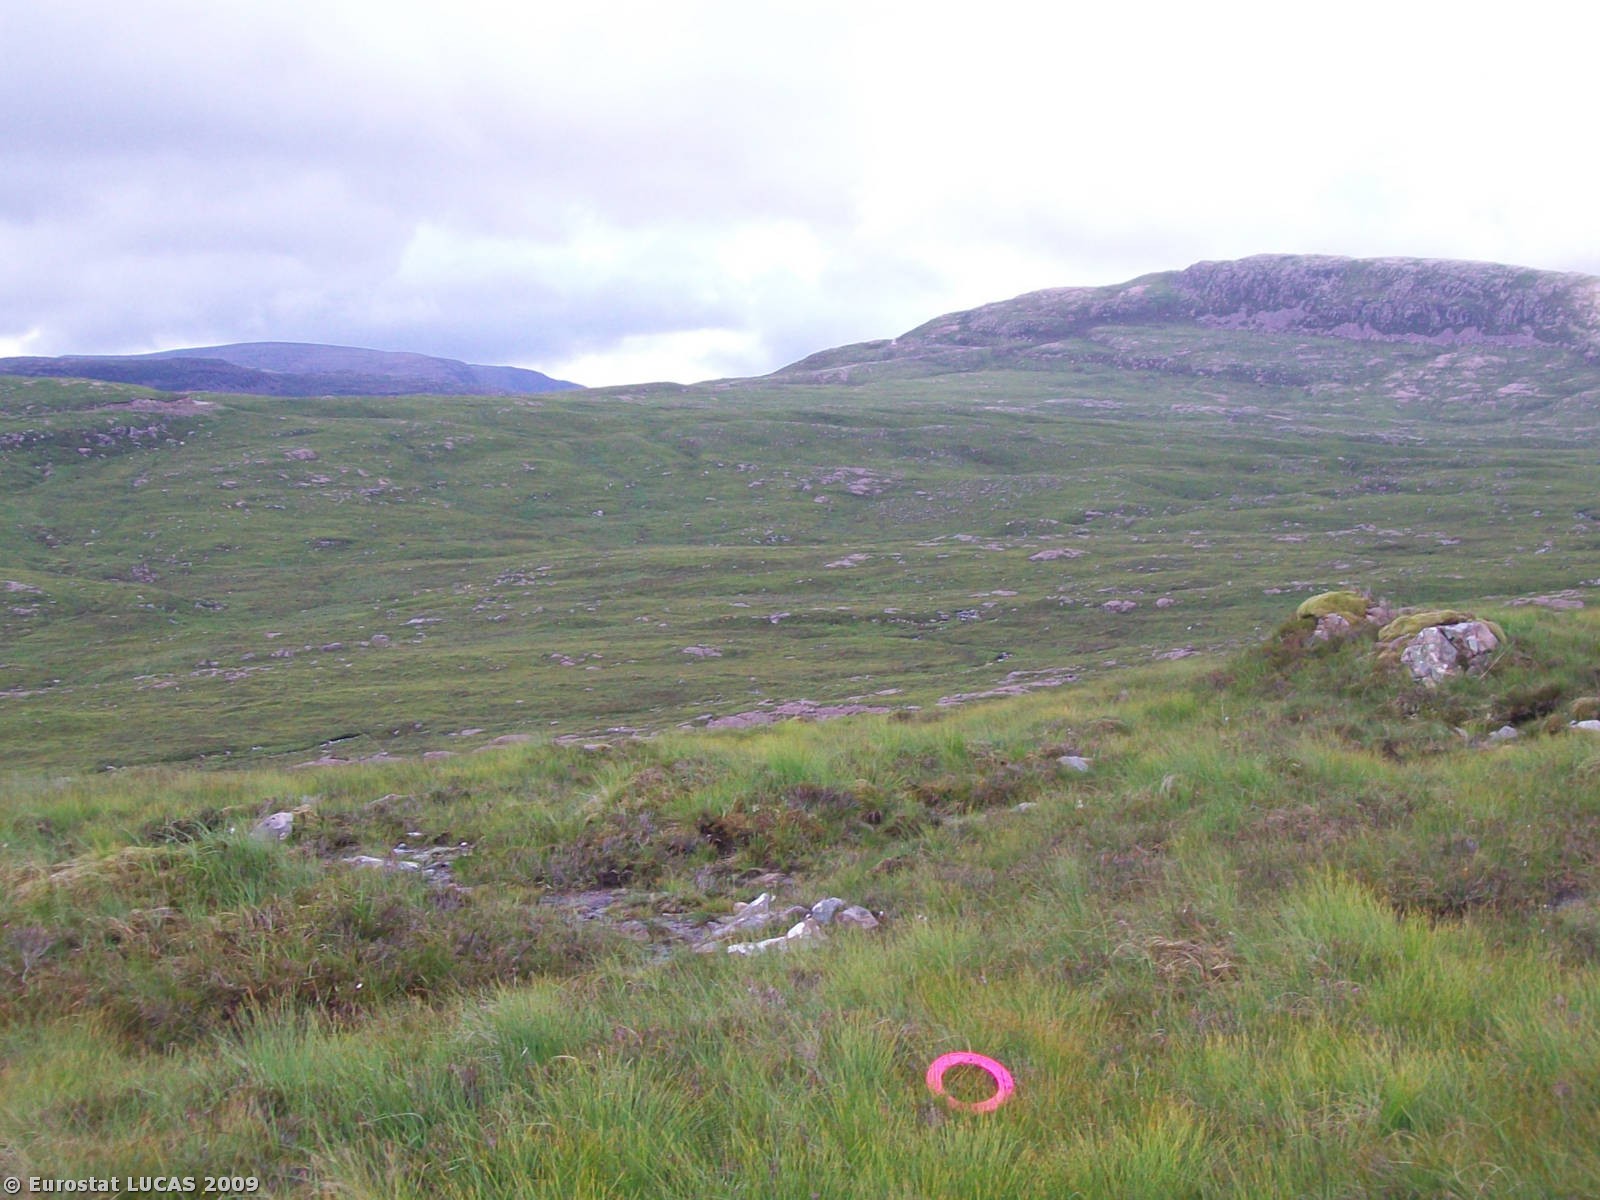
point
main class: Shrubland
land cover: Shrubland without tree cover
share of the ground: > 75 %
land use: Unused
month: July
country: GB
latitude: 57.4277
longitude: -5.7606
